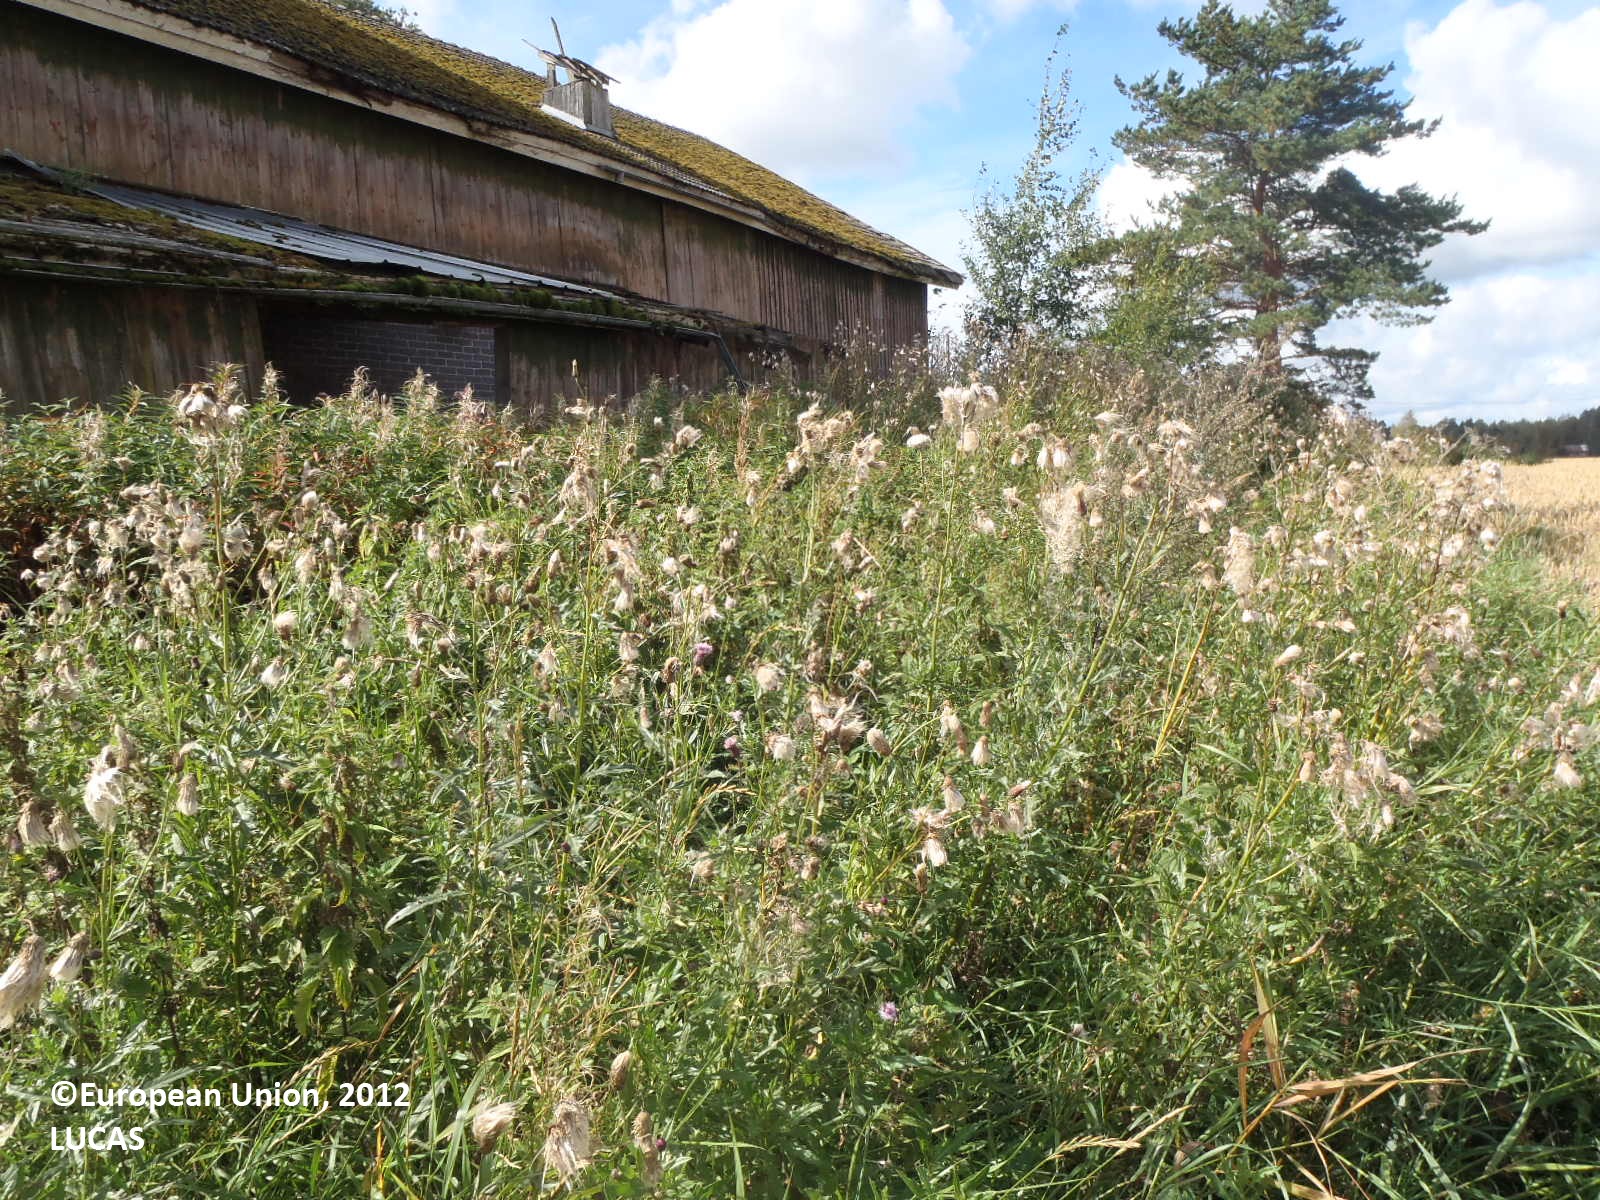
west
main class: Cropland
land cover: Common wheat
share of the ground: > 75 %
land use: Agriculture (excluding fallow land and kitchen gardens)
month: September
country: FI
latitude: 60.9078
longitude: 22.6253
